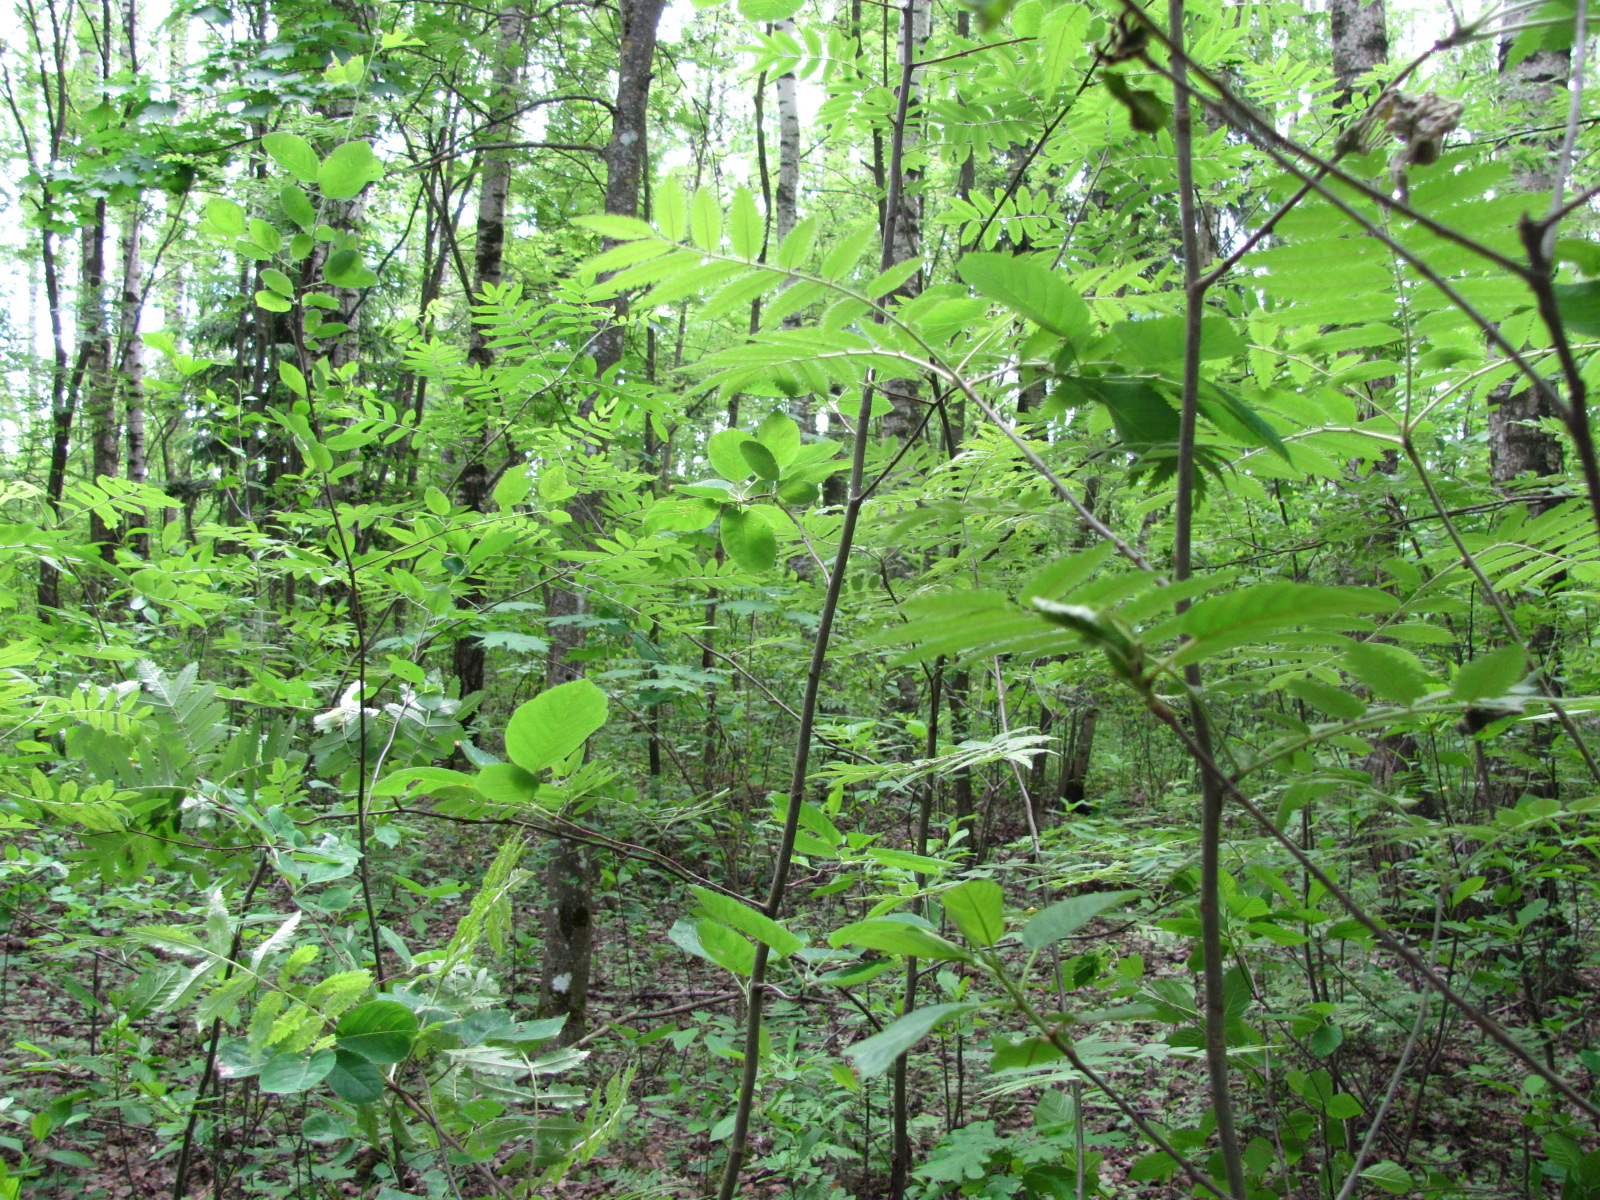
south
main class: Woodland
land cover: Broadleaved woodland
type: non-riverine alder, birch or aspen forest
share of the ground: > 75 %
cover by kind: broadleaved forest trees 100 %
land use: Forestry
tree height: > 5 m
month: June
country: LV
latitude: 56.6336
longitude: 23.8907
